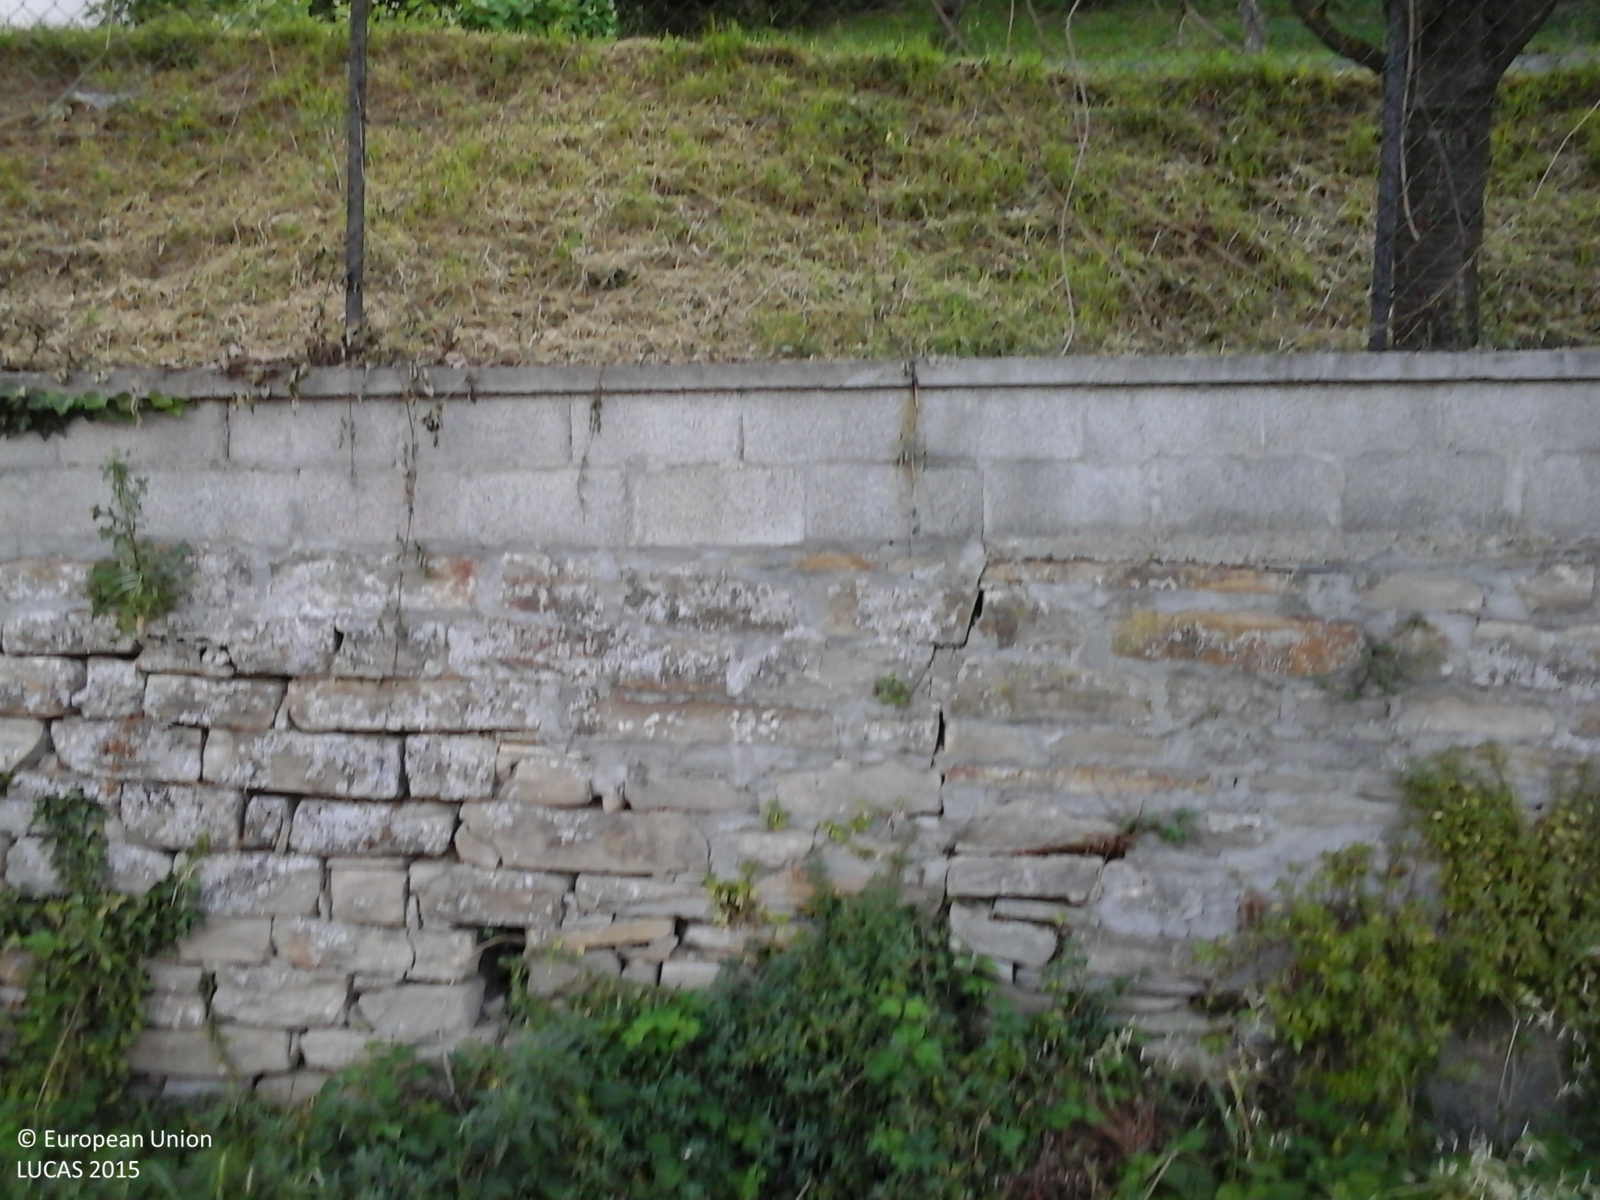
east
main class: Grassland
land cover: Grassland with sparse tree/shrub cover
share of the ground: > 75 %
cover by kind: herbaceous plants 90 %, broadleaved forest trees 5 %, shrubs 5 %
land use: Residential
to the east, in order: Grassland with sparse tree/shrub cover; Artificial constructions; Grassland with sparse tree/shrub cover; Broadleaved woodland; Electric lines; Grassland without tree/shrub cover; Artificial constructions in urban areas; Sunflower; Electric lines; Sunflower; Artificial constructions in urban areas; Sunflower; Grassland without tree/shrub cover; Broadleaved woodland
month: June
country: IT
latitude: 44.6453
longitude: 8.4272
